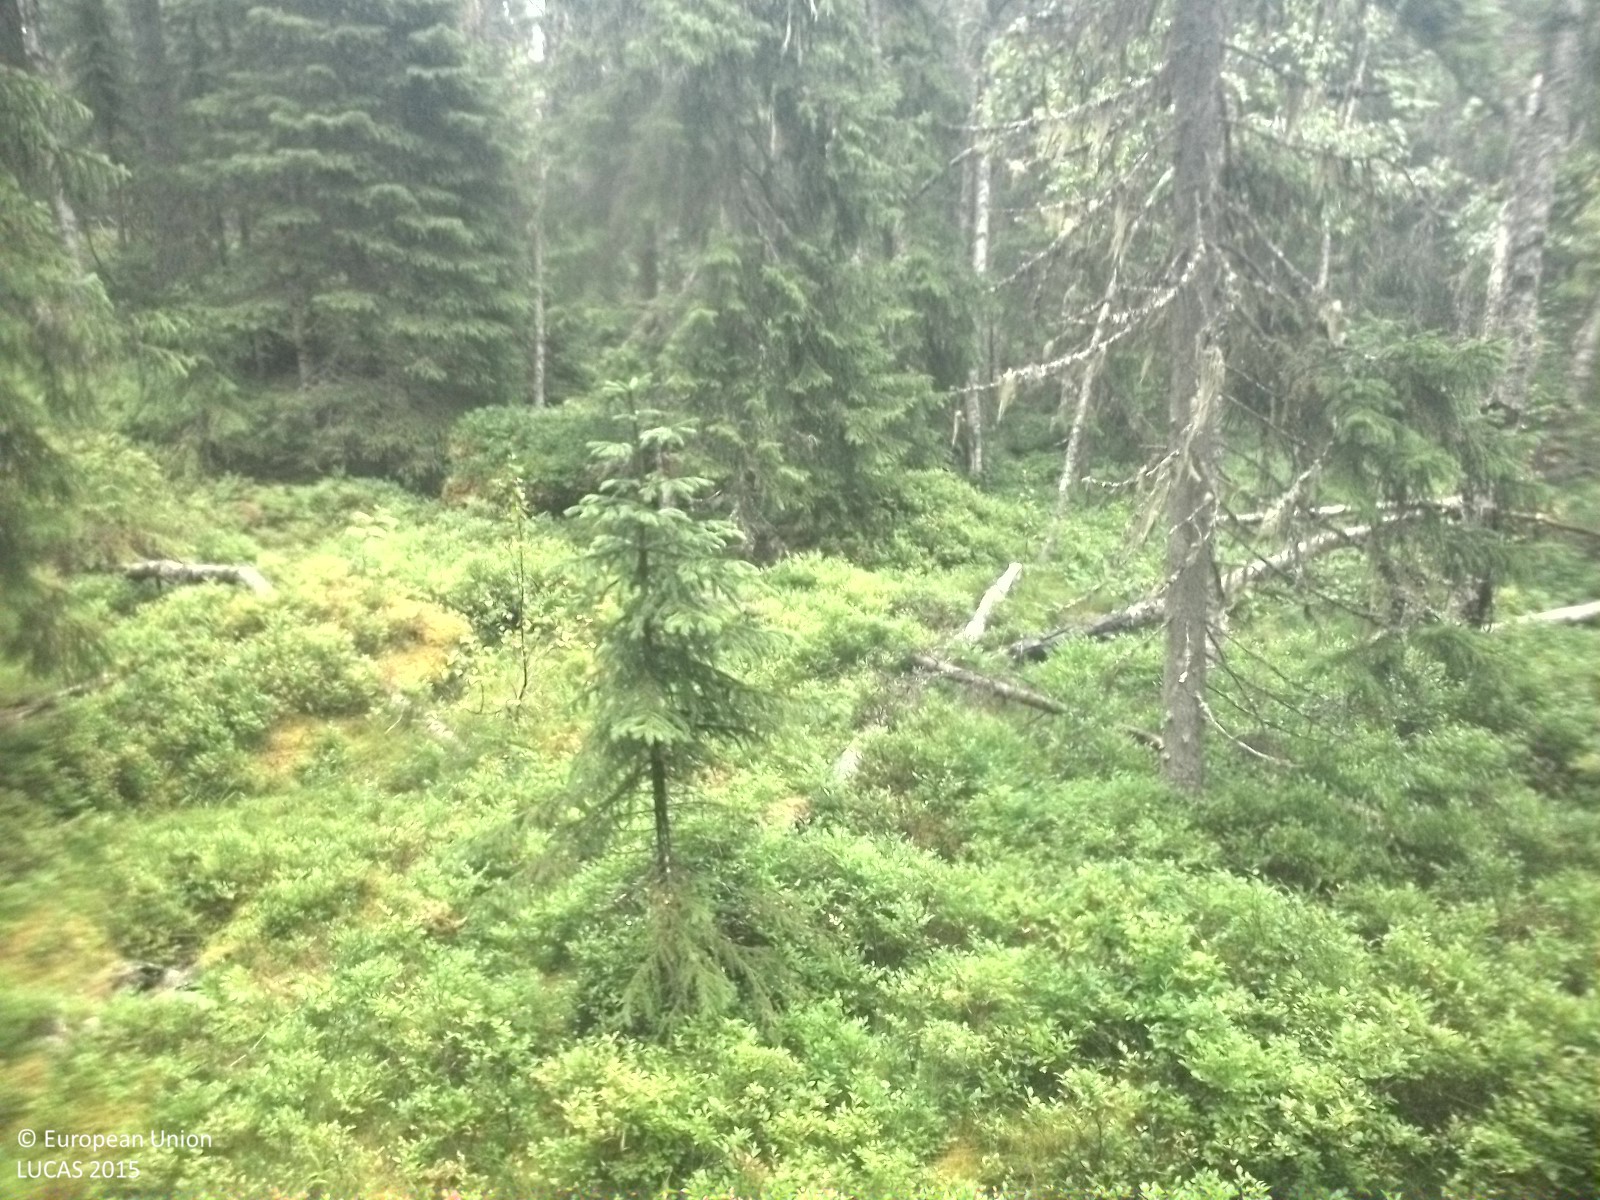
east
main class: Woodland
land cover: Spruce dominated coniferous woodland
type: boreal forest
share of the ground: 50 - 75 %
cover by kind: coniferous forest trees 55 %, shrubs 40 %, broadleaved forest trees 5 %
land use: Forestry
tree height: > 5 m
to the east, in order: Spruce dominated coniferous woodland; Spruce dominated mixed woodland; Spruce dominated coniferous woodland
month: August
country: SE
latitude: 62.2643
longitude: 16.2786
